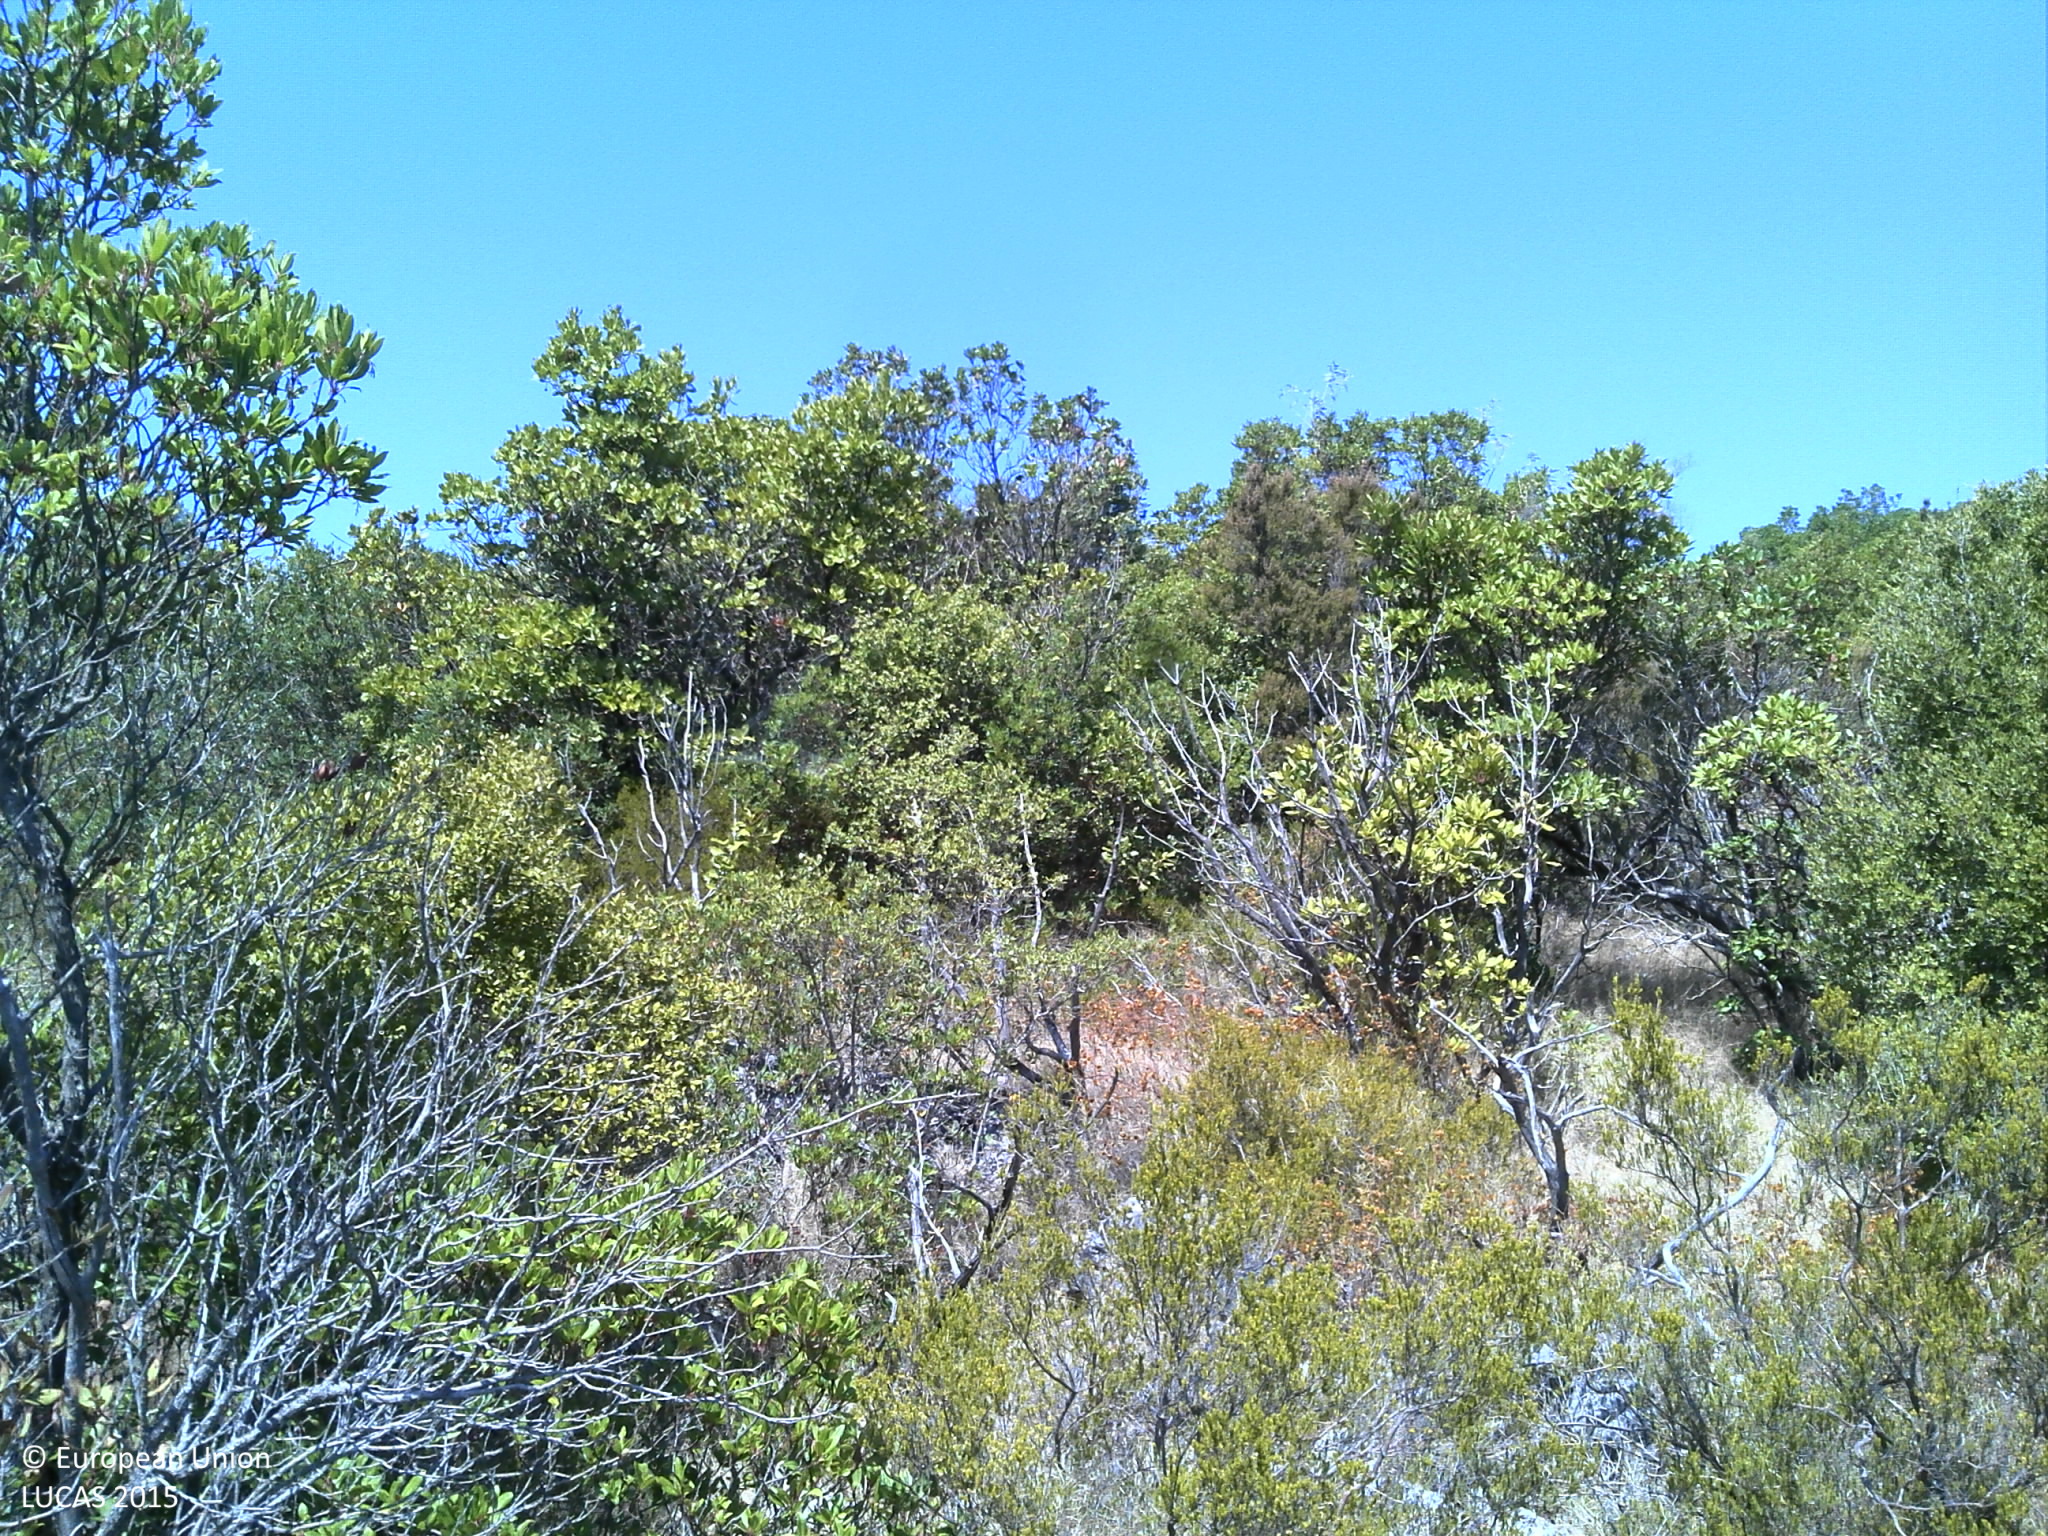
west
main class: Shrubland
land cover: Shrubland without tree cover
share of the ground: 50 - 75 %
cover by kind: shrubs 60 %, consolidated bare surface 15 %, unconsolidated bare surface 15 %, herbaceous plants 10 %
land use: Semi-natural and natural areas not in use
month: August
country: HR
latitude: 42.9510
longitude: 17.0615
